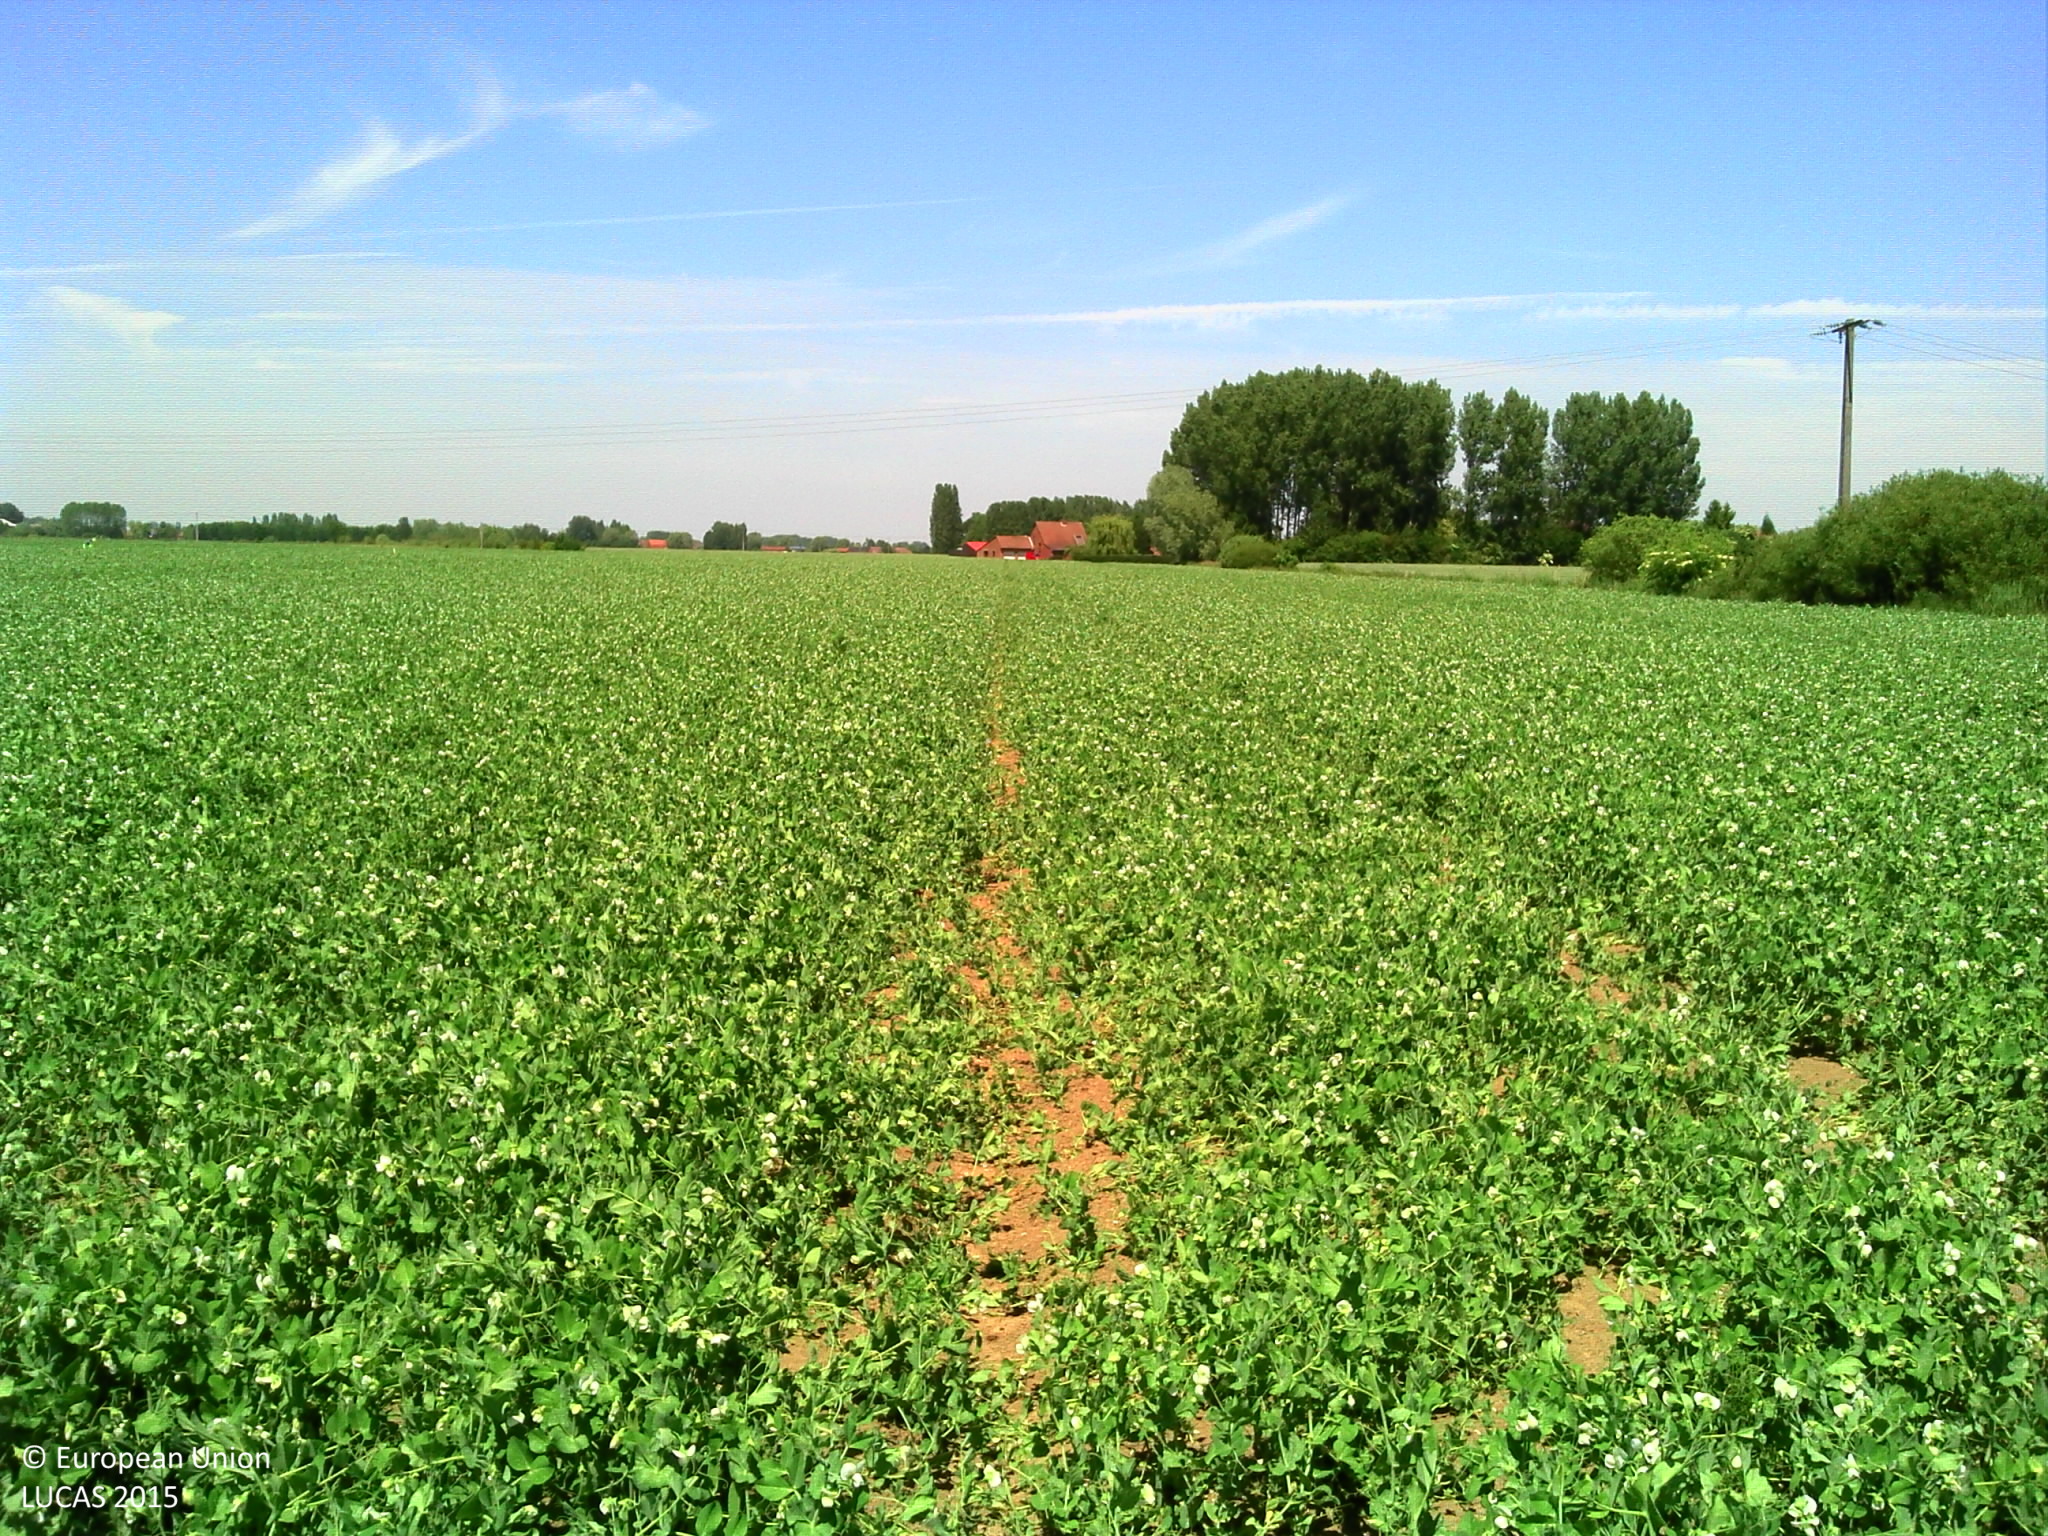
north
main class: Cropland
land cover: Other fresh vegetables
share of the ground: > 75 %
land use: Agriculture (excluding fallow land and kitchen gardens)
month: June
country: FR
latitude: 50.5490
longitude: 2.7487
